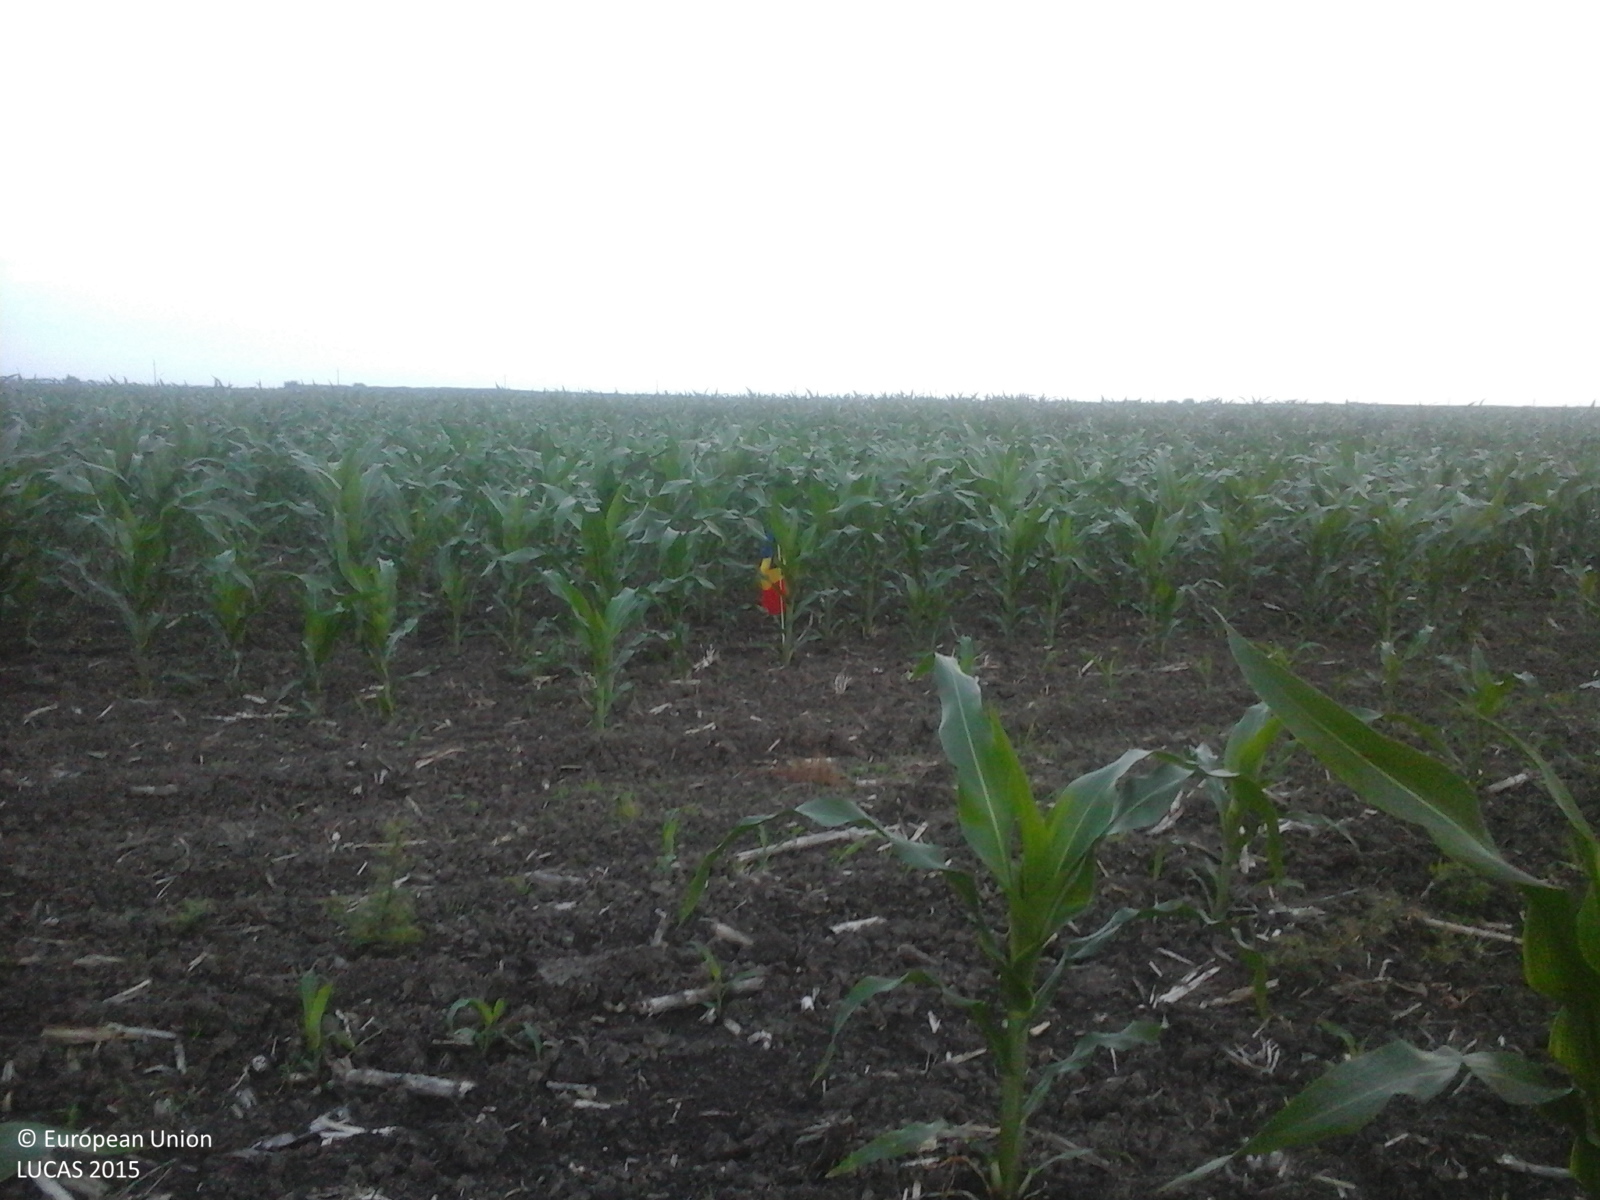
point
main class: Cropland
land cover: Maize
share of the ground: 25 - 50 %
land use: Agriculture (excluding fallow land and kitchen gardens)
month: June
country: RO
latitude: 44.0365
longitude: 26.1111
